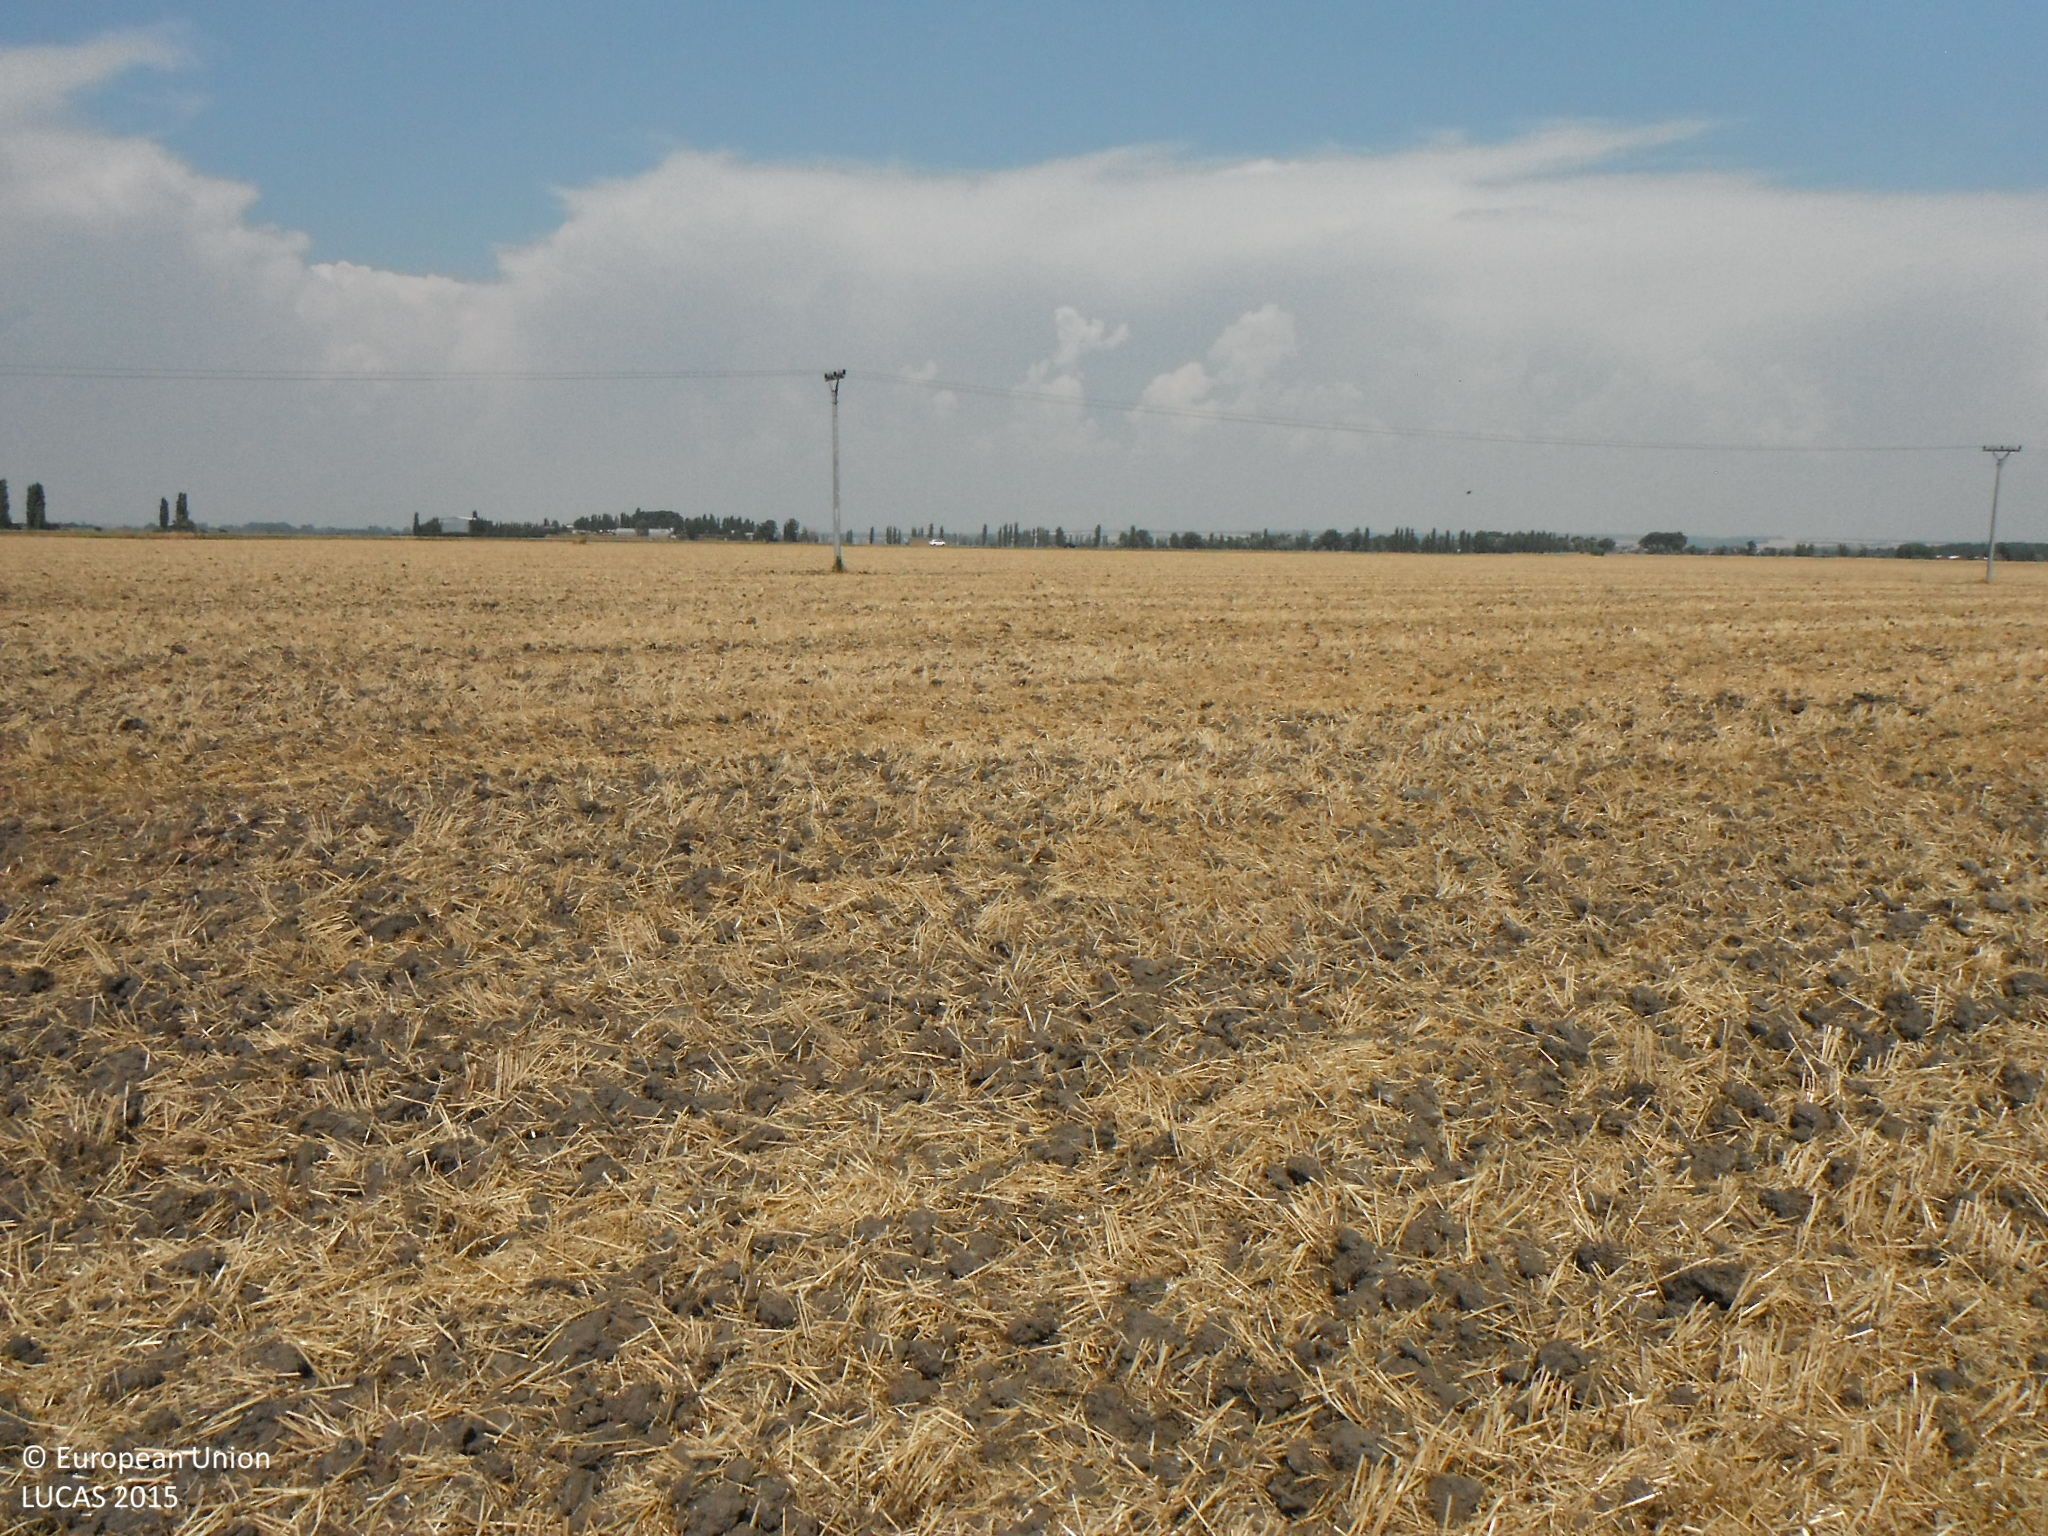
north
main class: Cropland
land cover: Common wheat
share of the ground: > 75 %
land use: Agriculture (excluding fallow land and kitchen gardens)
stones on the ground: < 10 %
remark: Harvested field
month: August
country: SK
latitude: 47.9880
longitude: 18.2275
